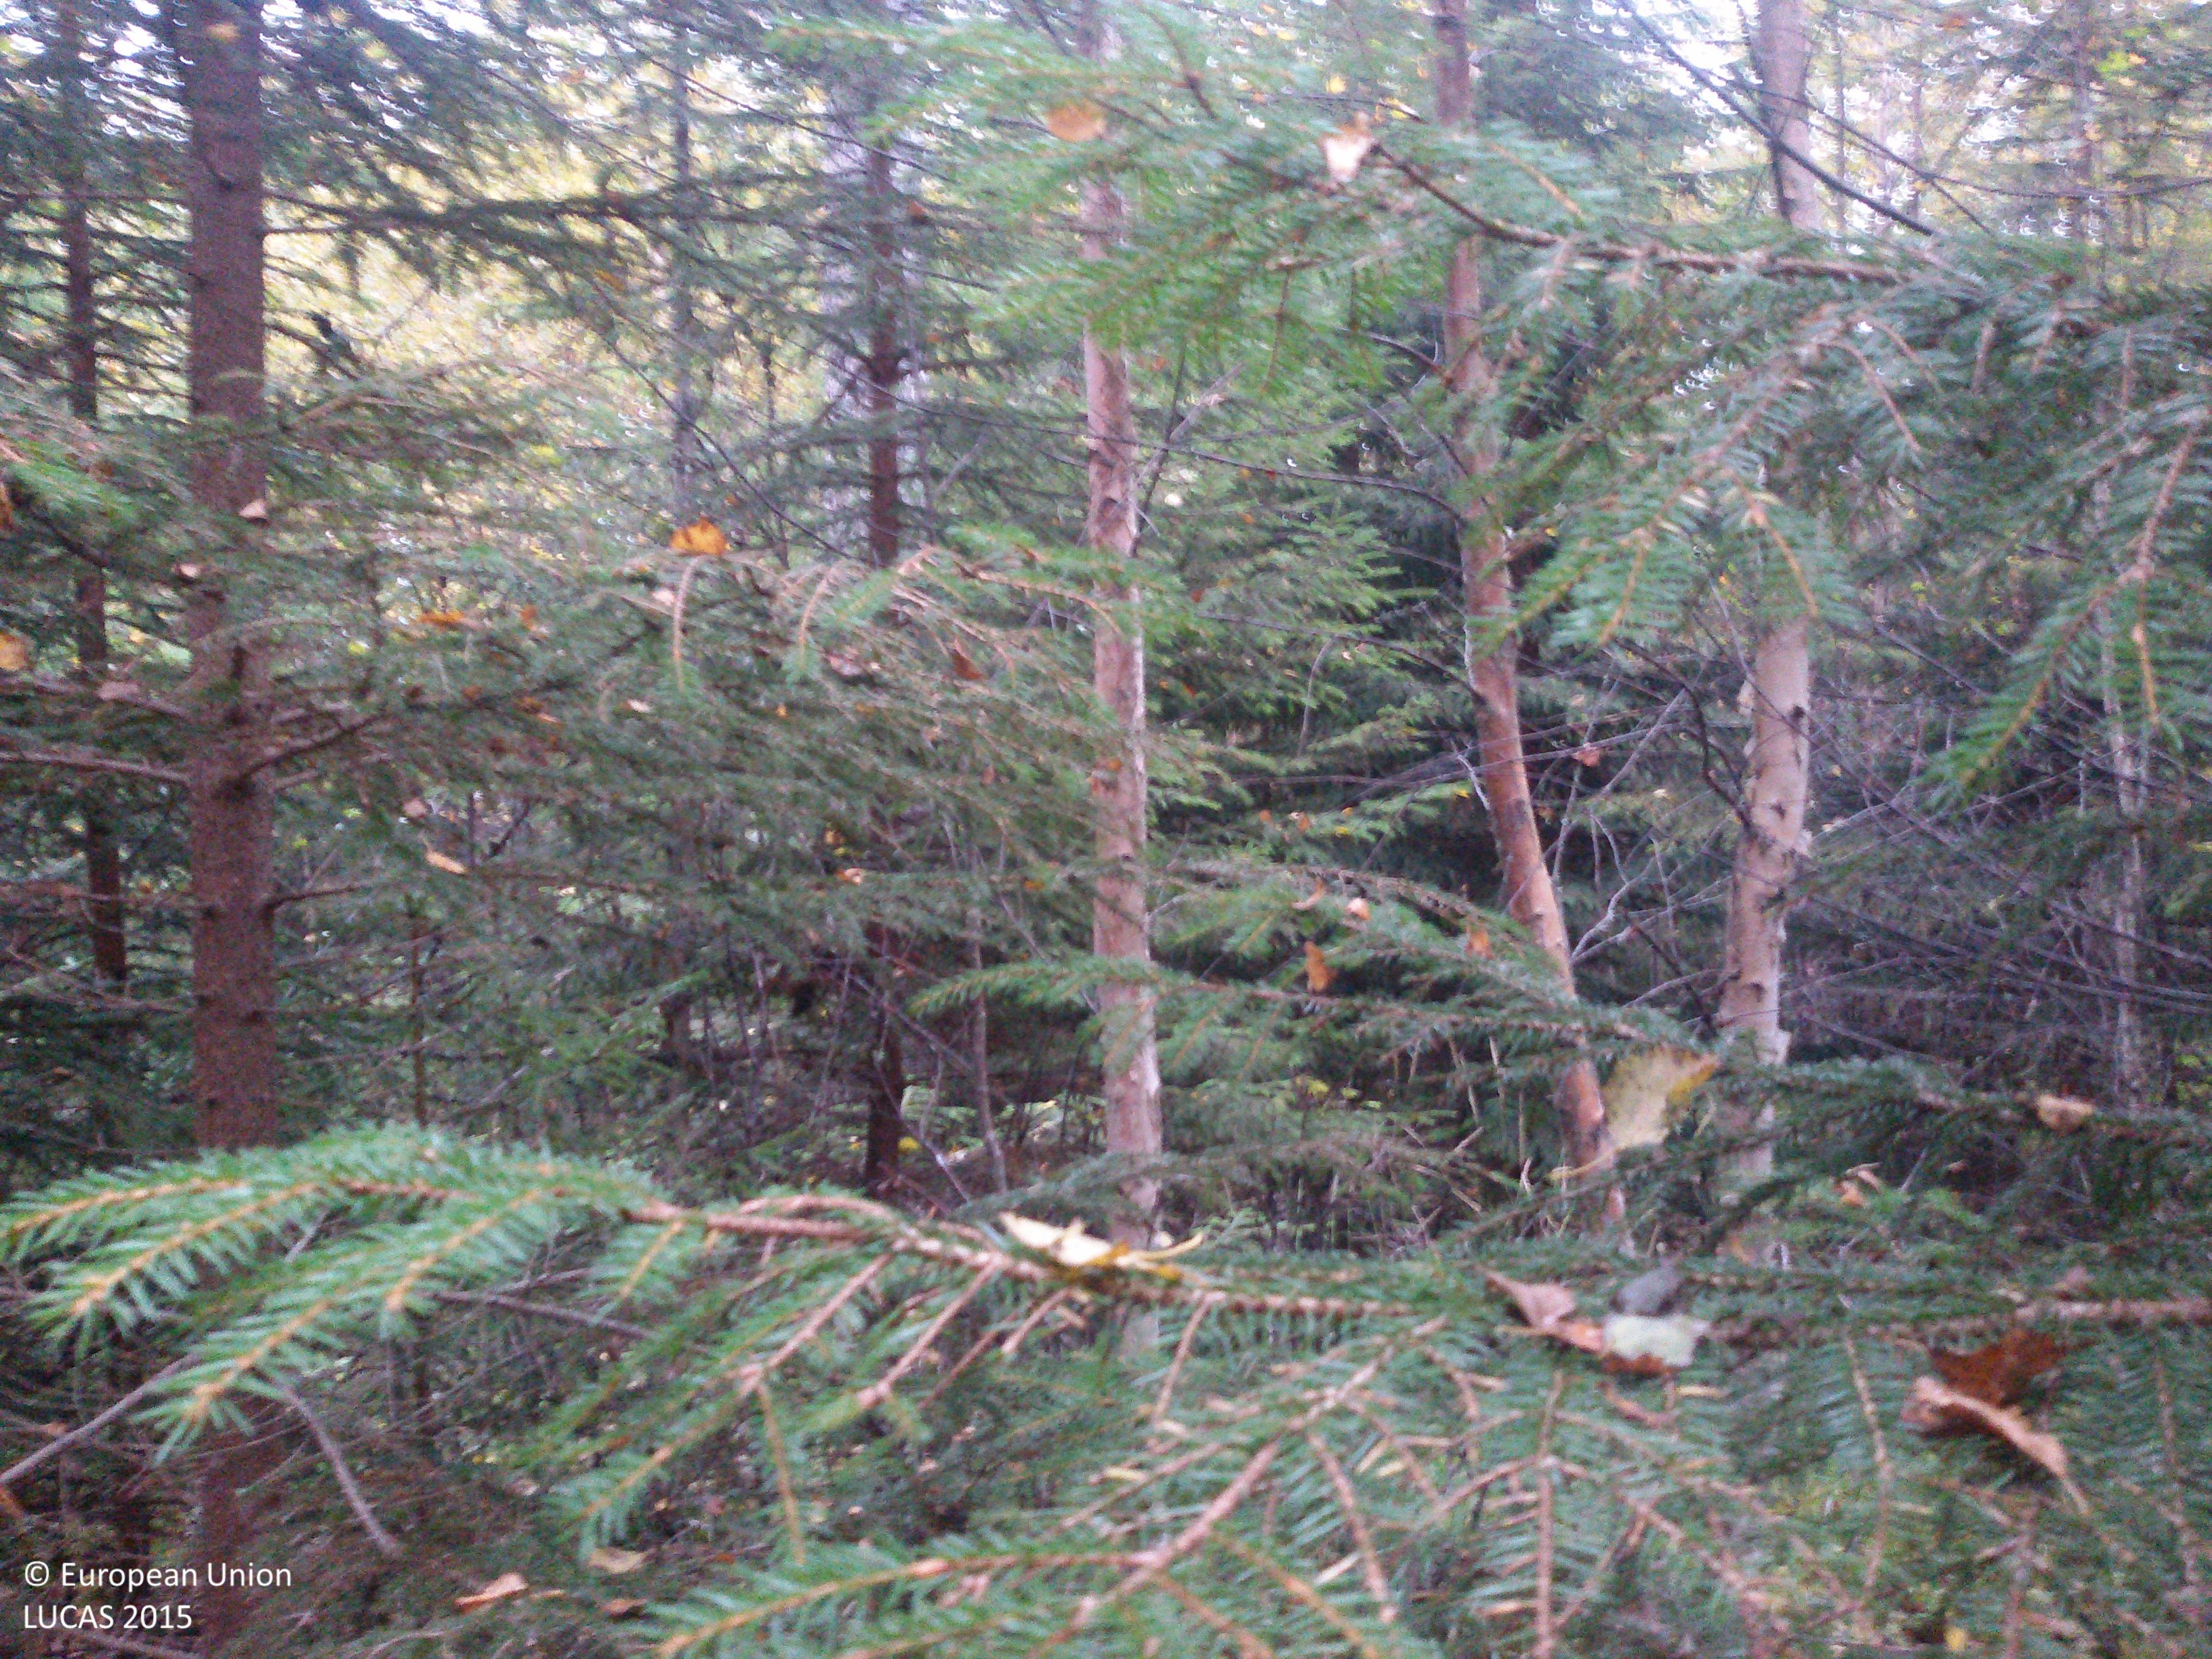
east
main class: Woodland
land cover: Spruce dominated mixed woodland
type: boreal forest
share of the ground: > 75 %
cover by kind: coniferous forest trees 50 %, broadleaved forest trees 40 %, herbaceous plants 10 %
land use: Forestry
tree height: > 5 m
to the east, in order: Spruce dominated mixed woodland; Ditches and canals; Paved roads, cycling and walking lanes; Ditches and canals; Spruce dominated mixed woodland; Spruce dominated coniferous woodland
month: September
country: SE
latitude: 60.6738
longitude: 14.8743
